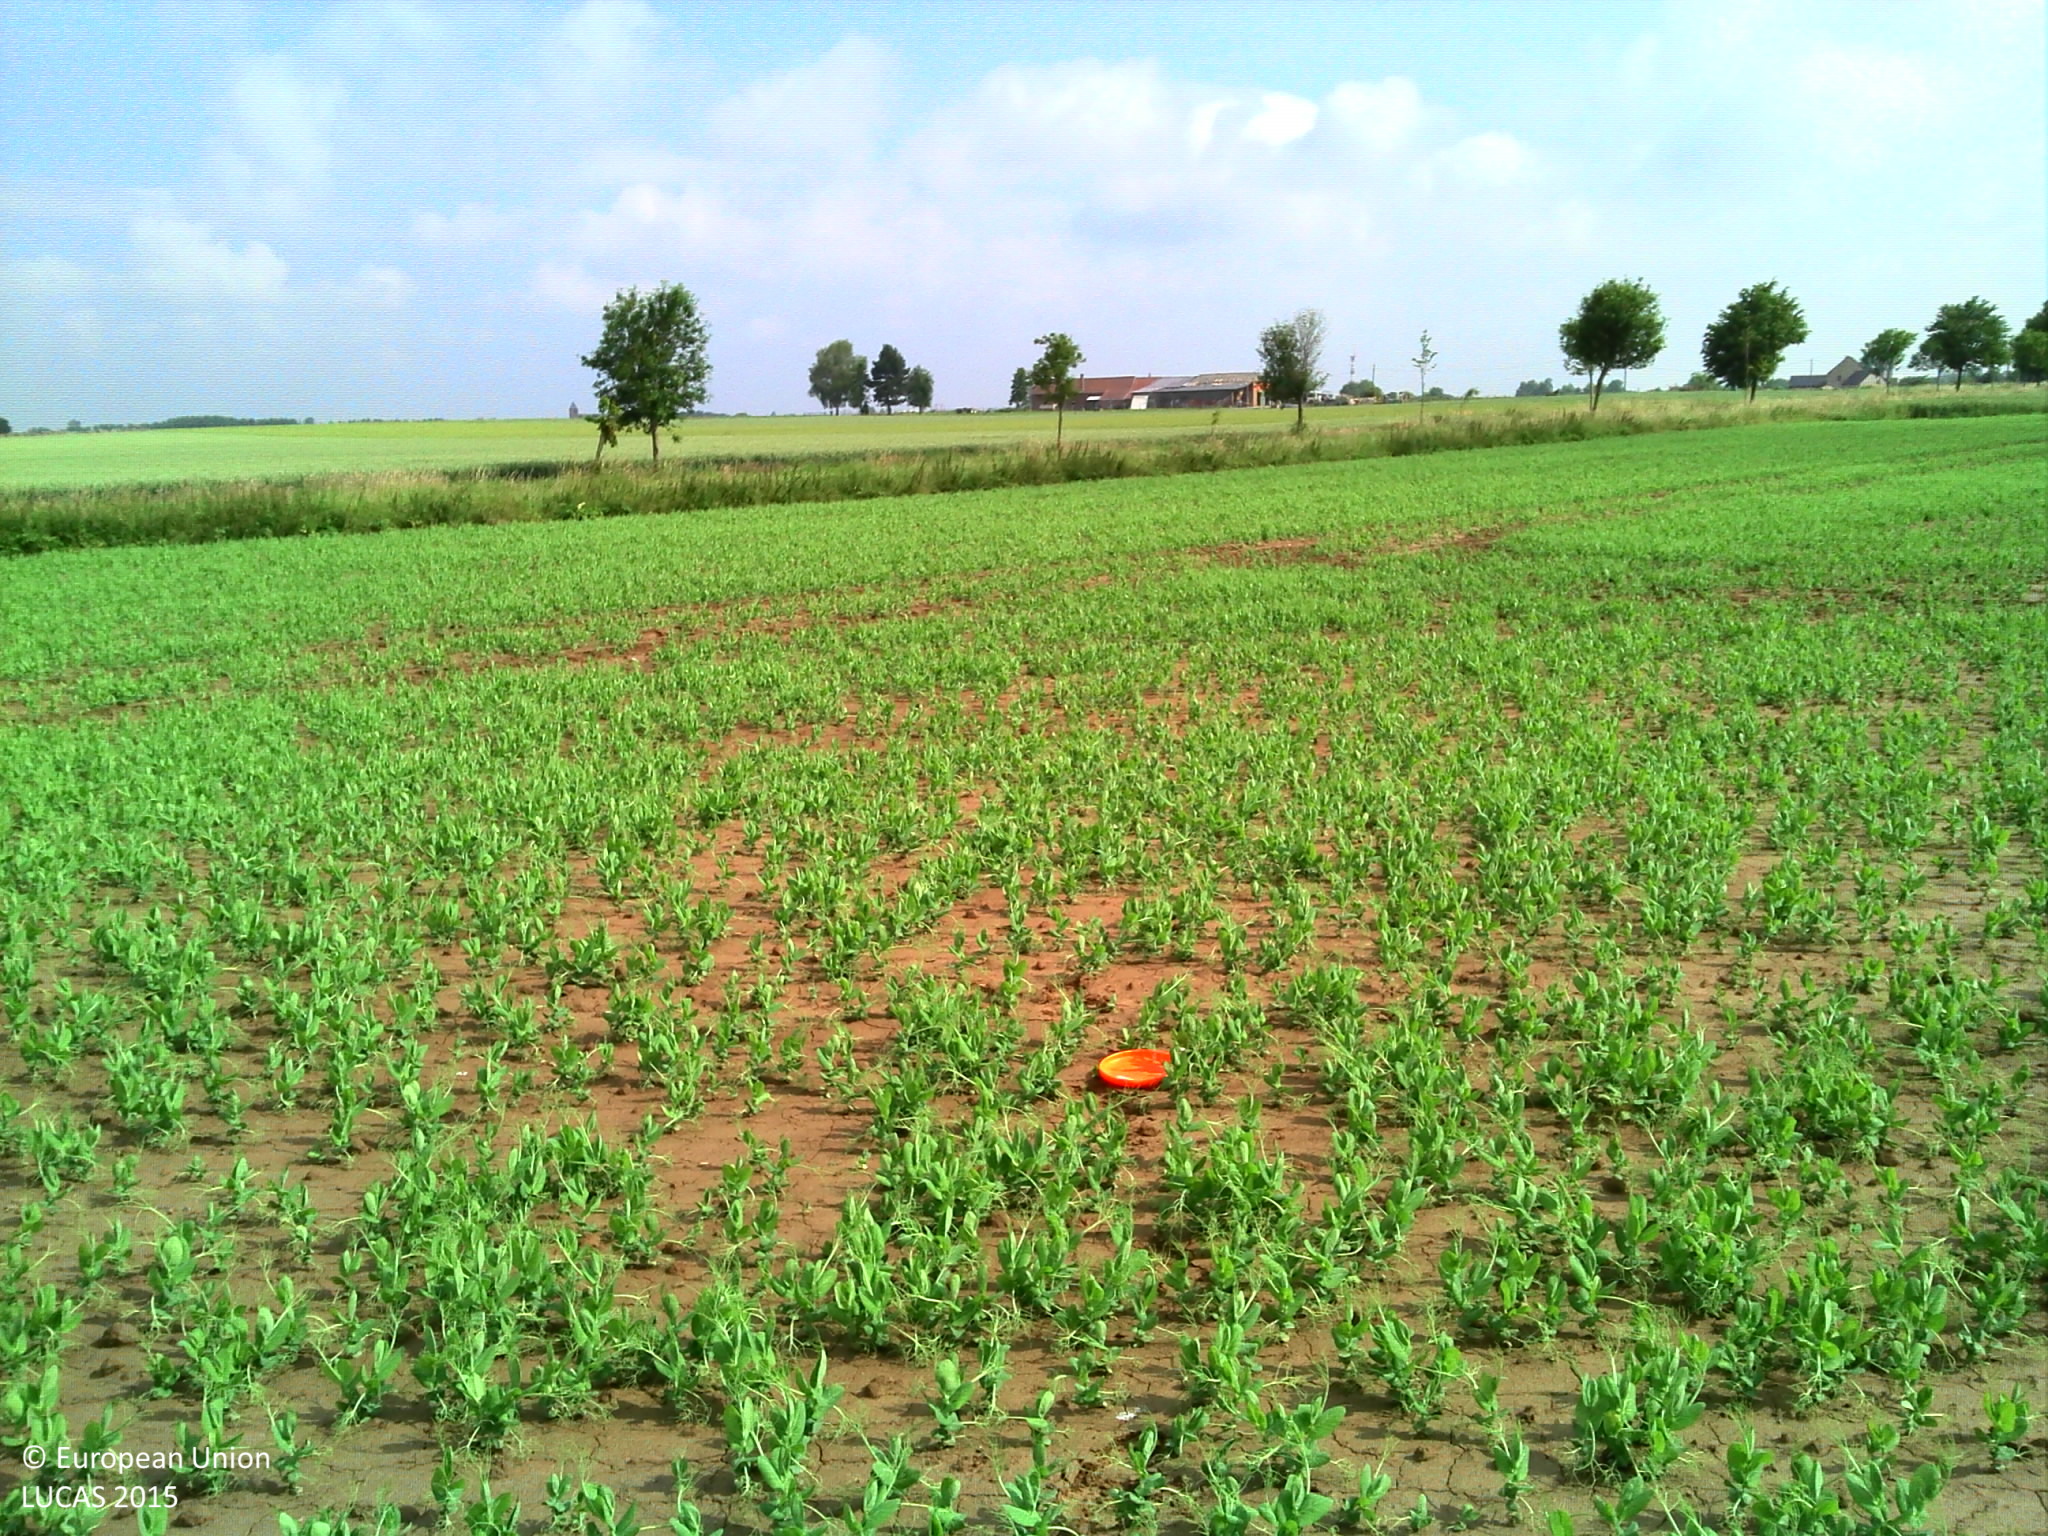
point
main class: Cropland
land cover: Dry pulses
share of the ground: 50 - 75 %
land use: Agriculture (excluding fallow land and kitchen gardens)
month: June
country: BE
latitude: 50.5743
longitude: 3.7945
